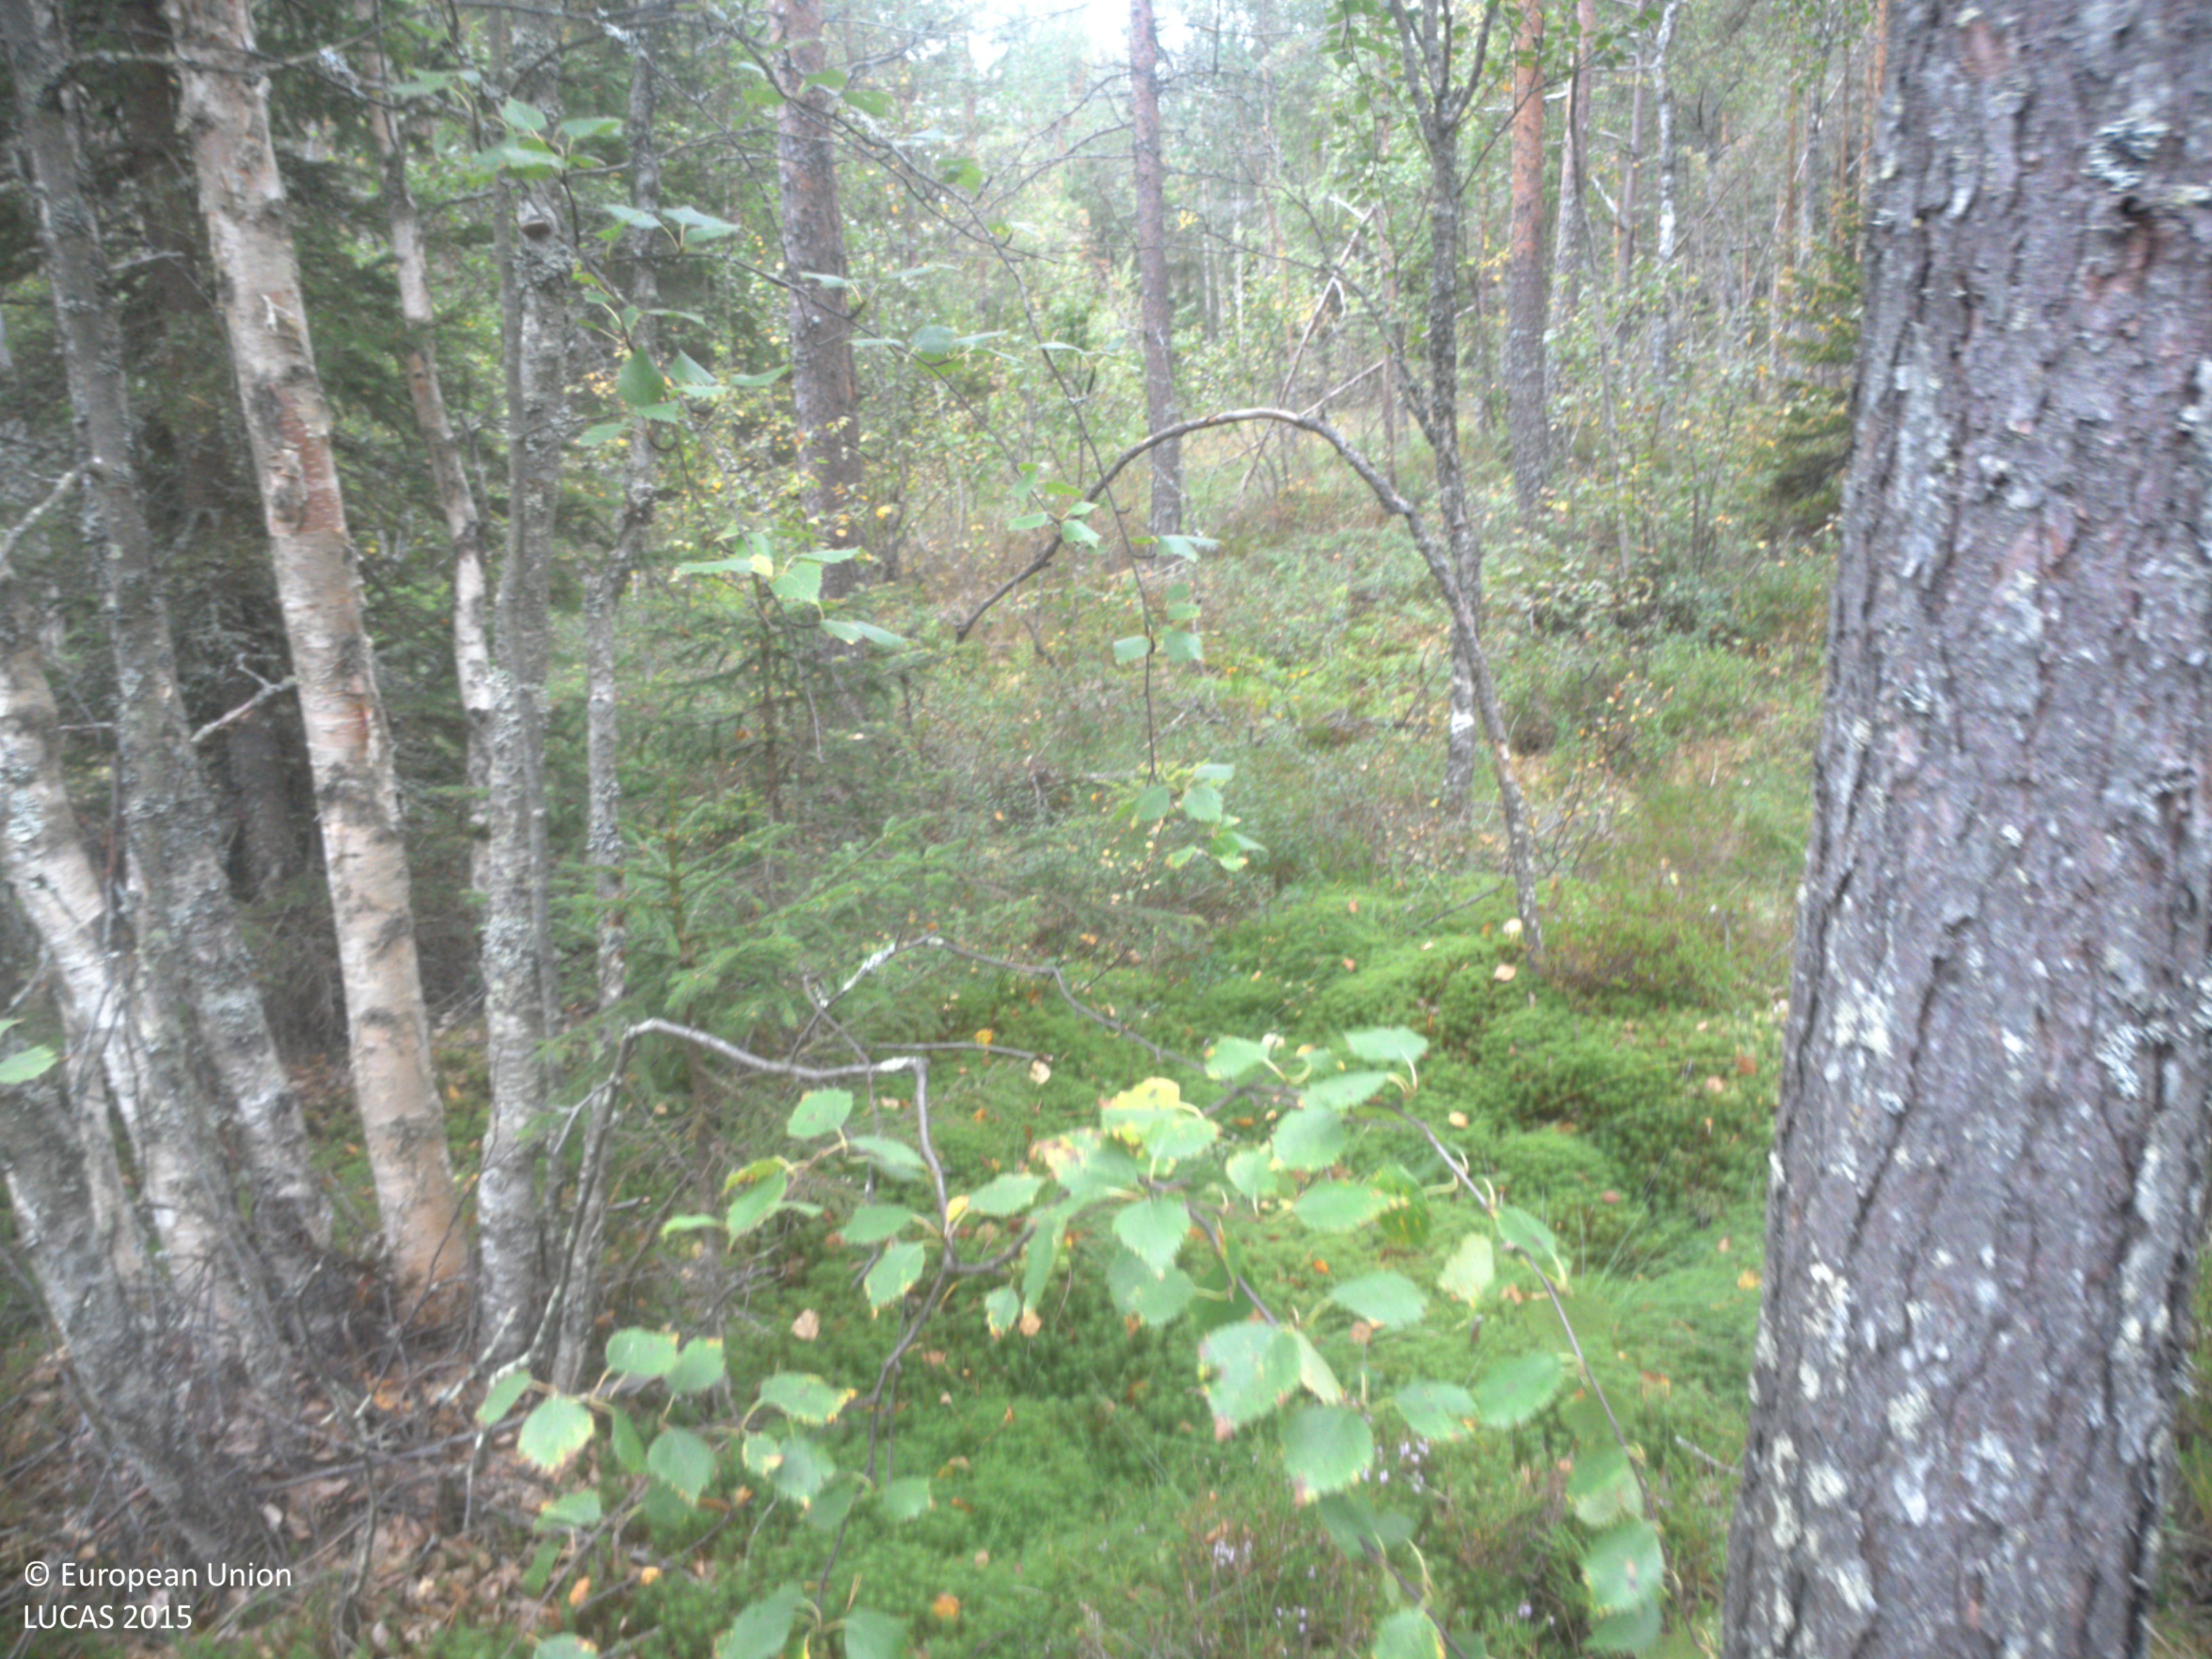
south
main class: Woodland
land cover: Pine dominated mixed woodland
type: boreal forest
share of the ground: 50 - 75 %
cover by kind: coniferous forest trees 40 %, shrubs 40 %, broadleaved forest trees 20 %
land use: Forestry
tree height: > 5 m
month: August
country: SE
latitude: 63.7352
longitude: 20.0069
